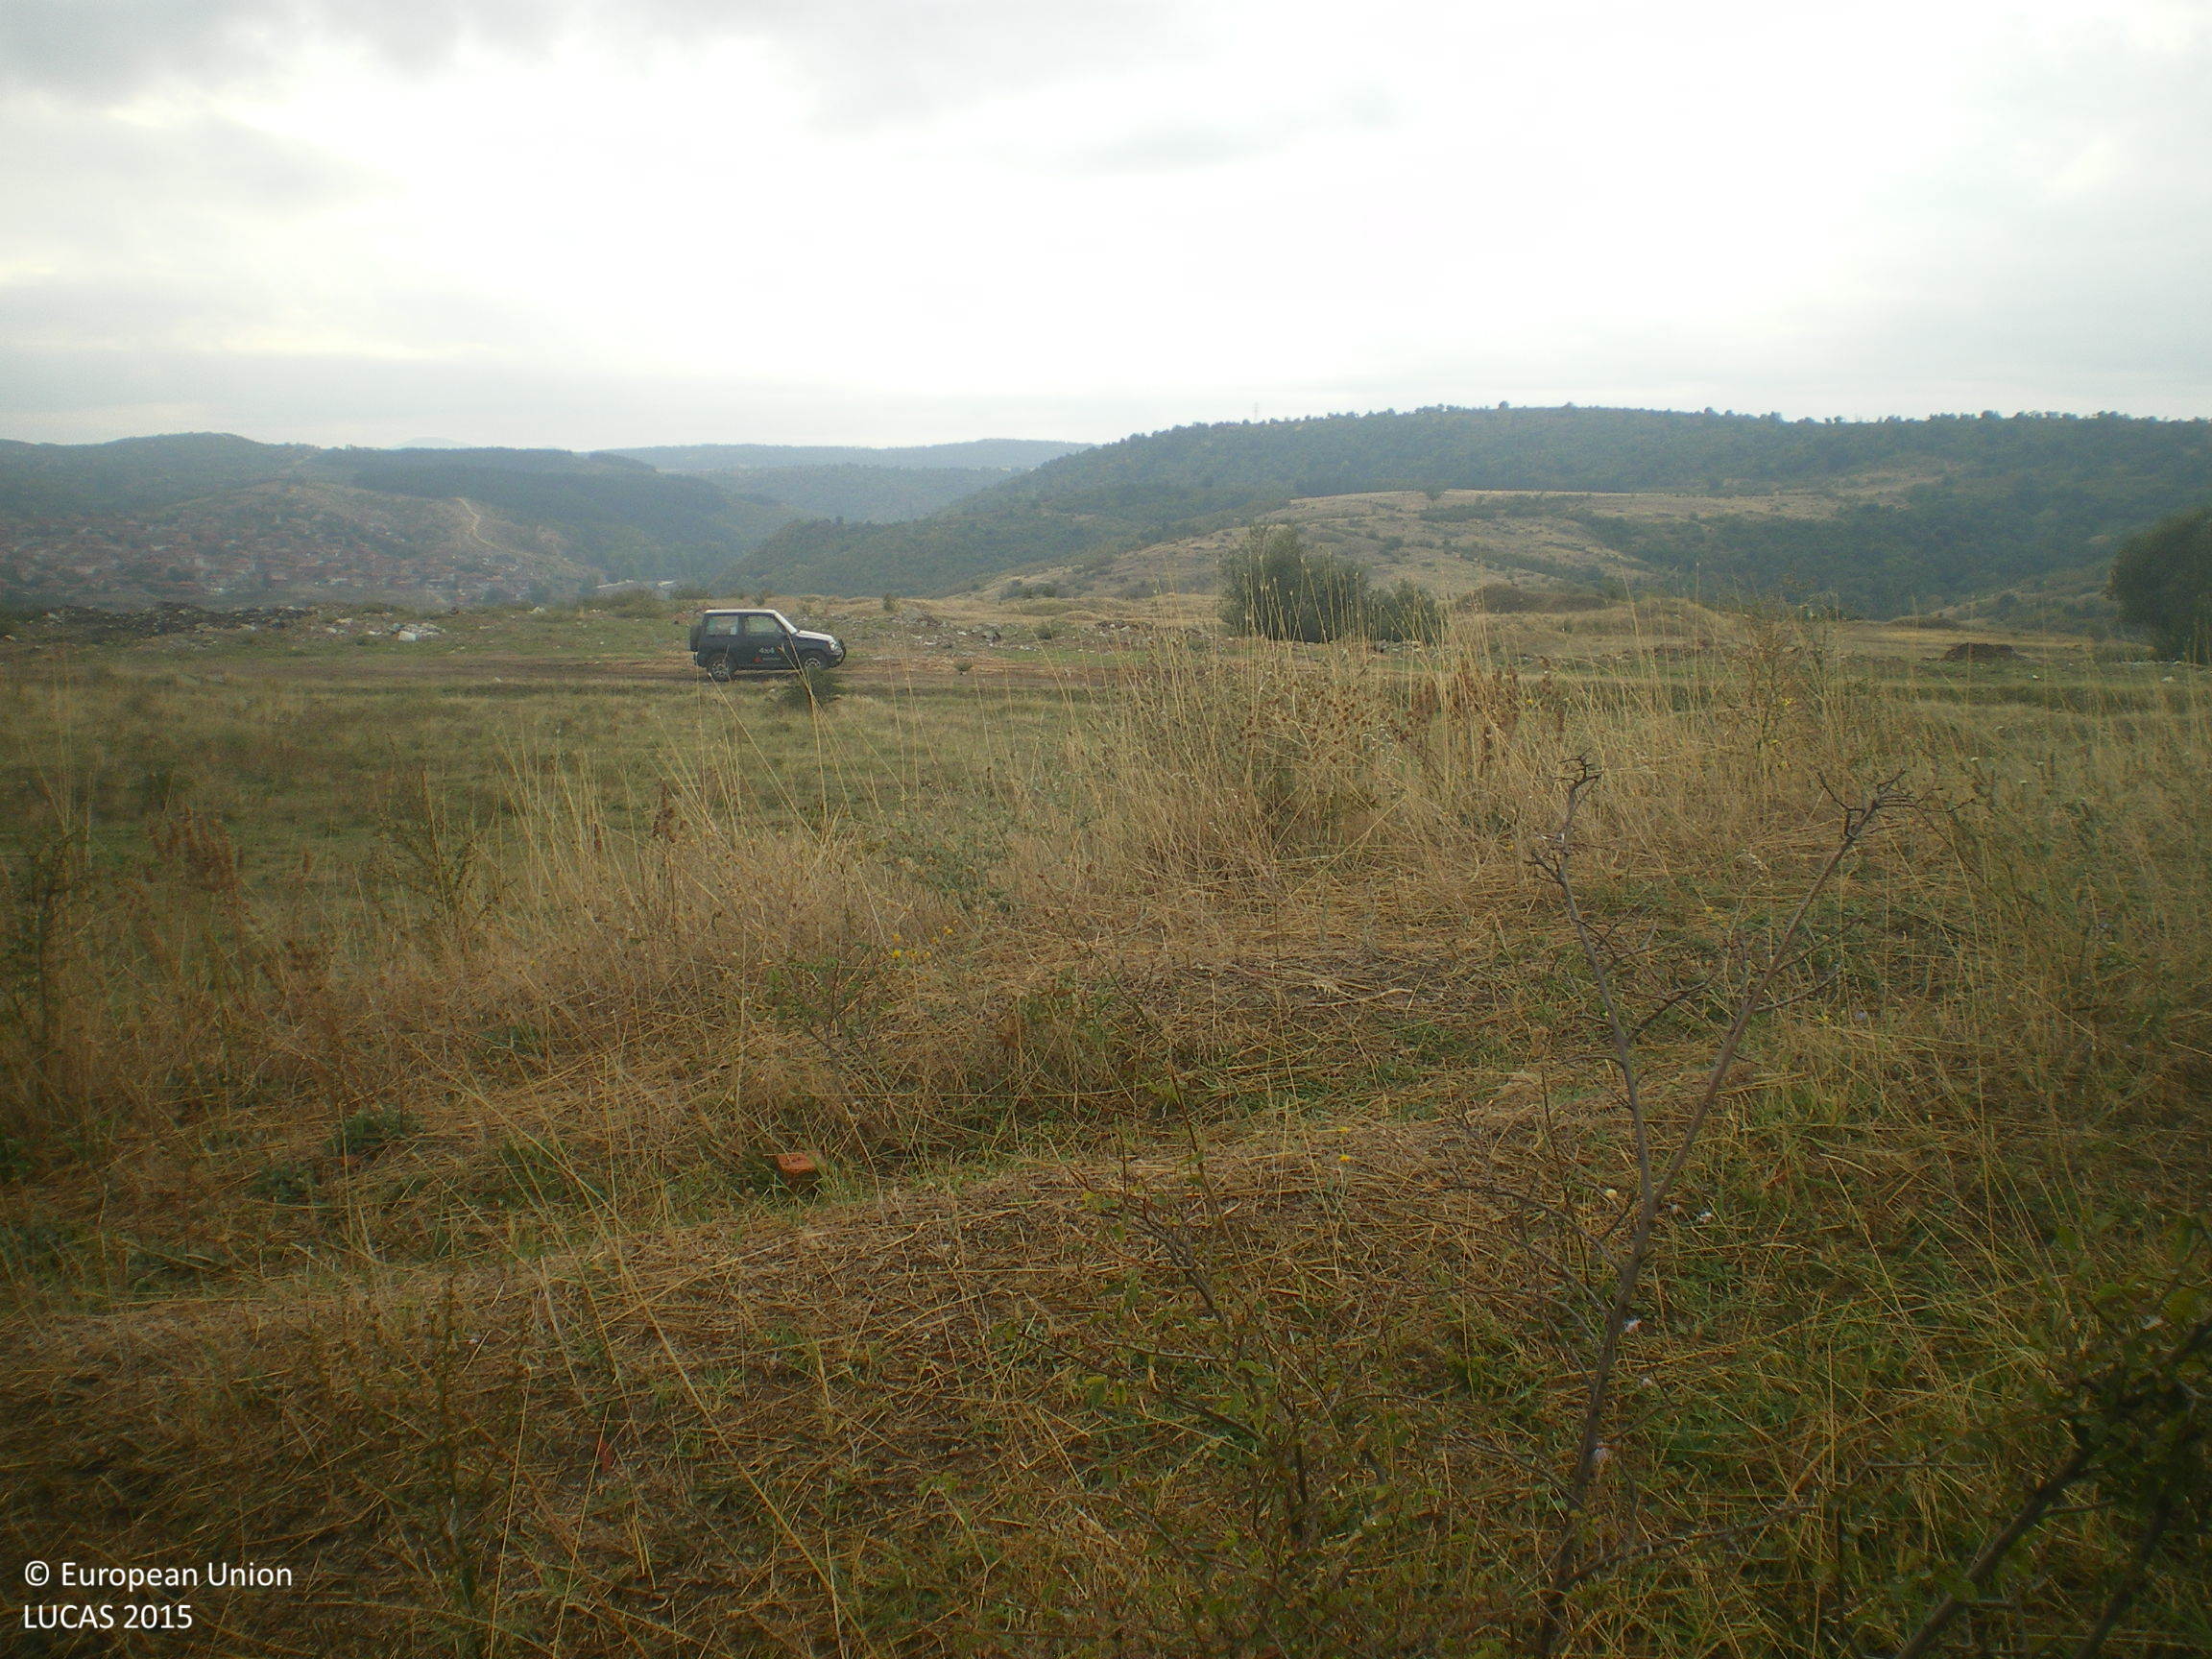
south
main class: Grassland
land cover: Grassland with sparse tree/shrub cover
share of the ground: > 75 %
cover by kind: herbaceous plants 90 %, broadleaved forest trees 5 %, shrubs 5 %
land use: Waste treatment
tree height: > 5 m
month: September
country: BG
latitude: 41.9423
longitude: 25.8844
